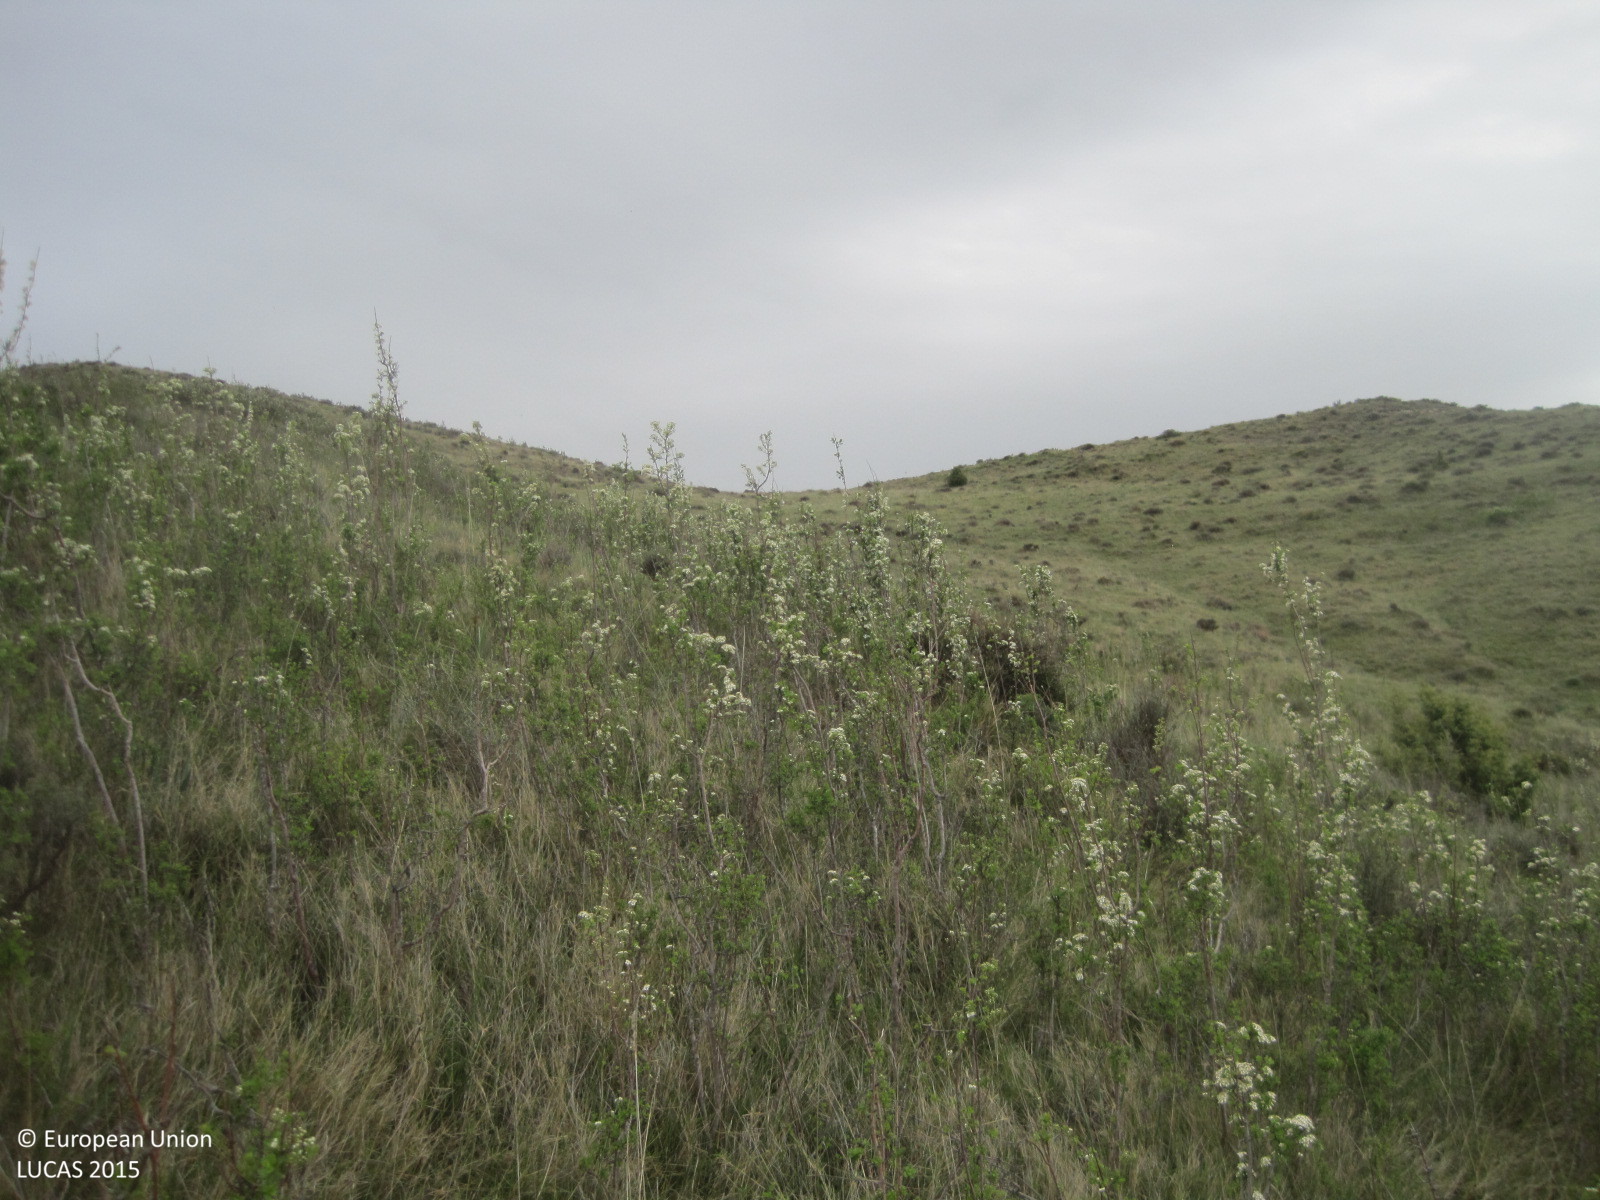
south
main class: Shrubland
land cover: Shrubland without tree cover
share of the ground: > 75 %
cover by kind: shrubs 70 %, herbaceous plants 30 %
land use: Semi-natural and natural areas not in use
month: April
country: ES
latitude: 42.5894
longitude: -2.1924
